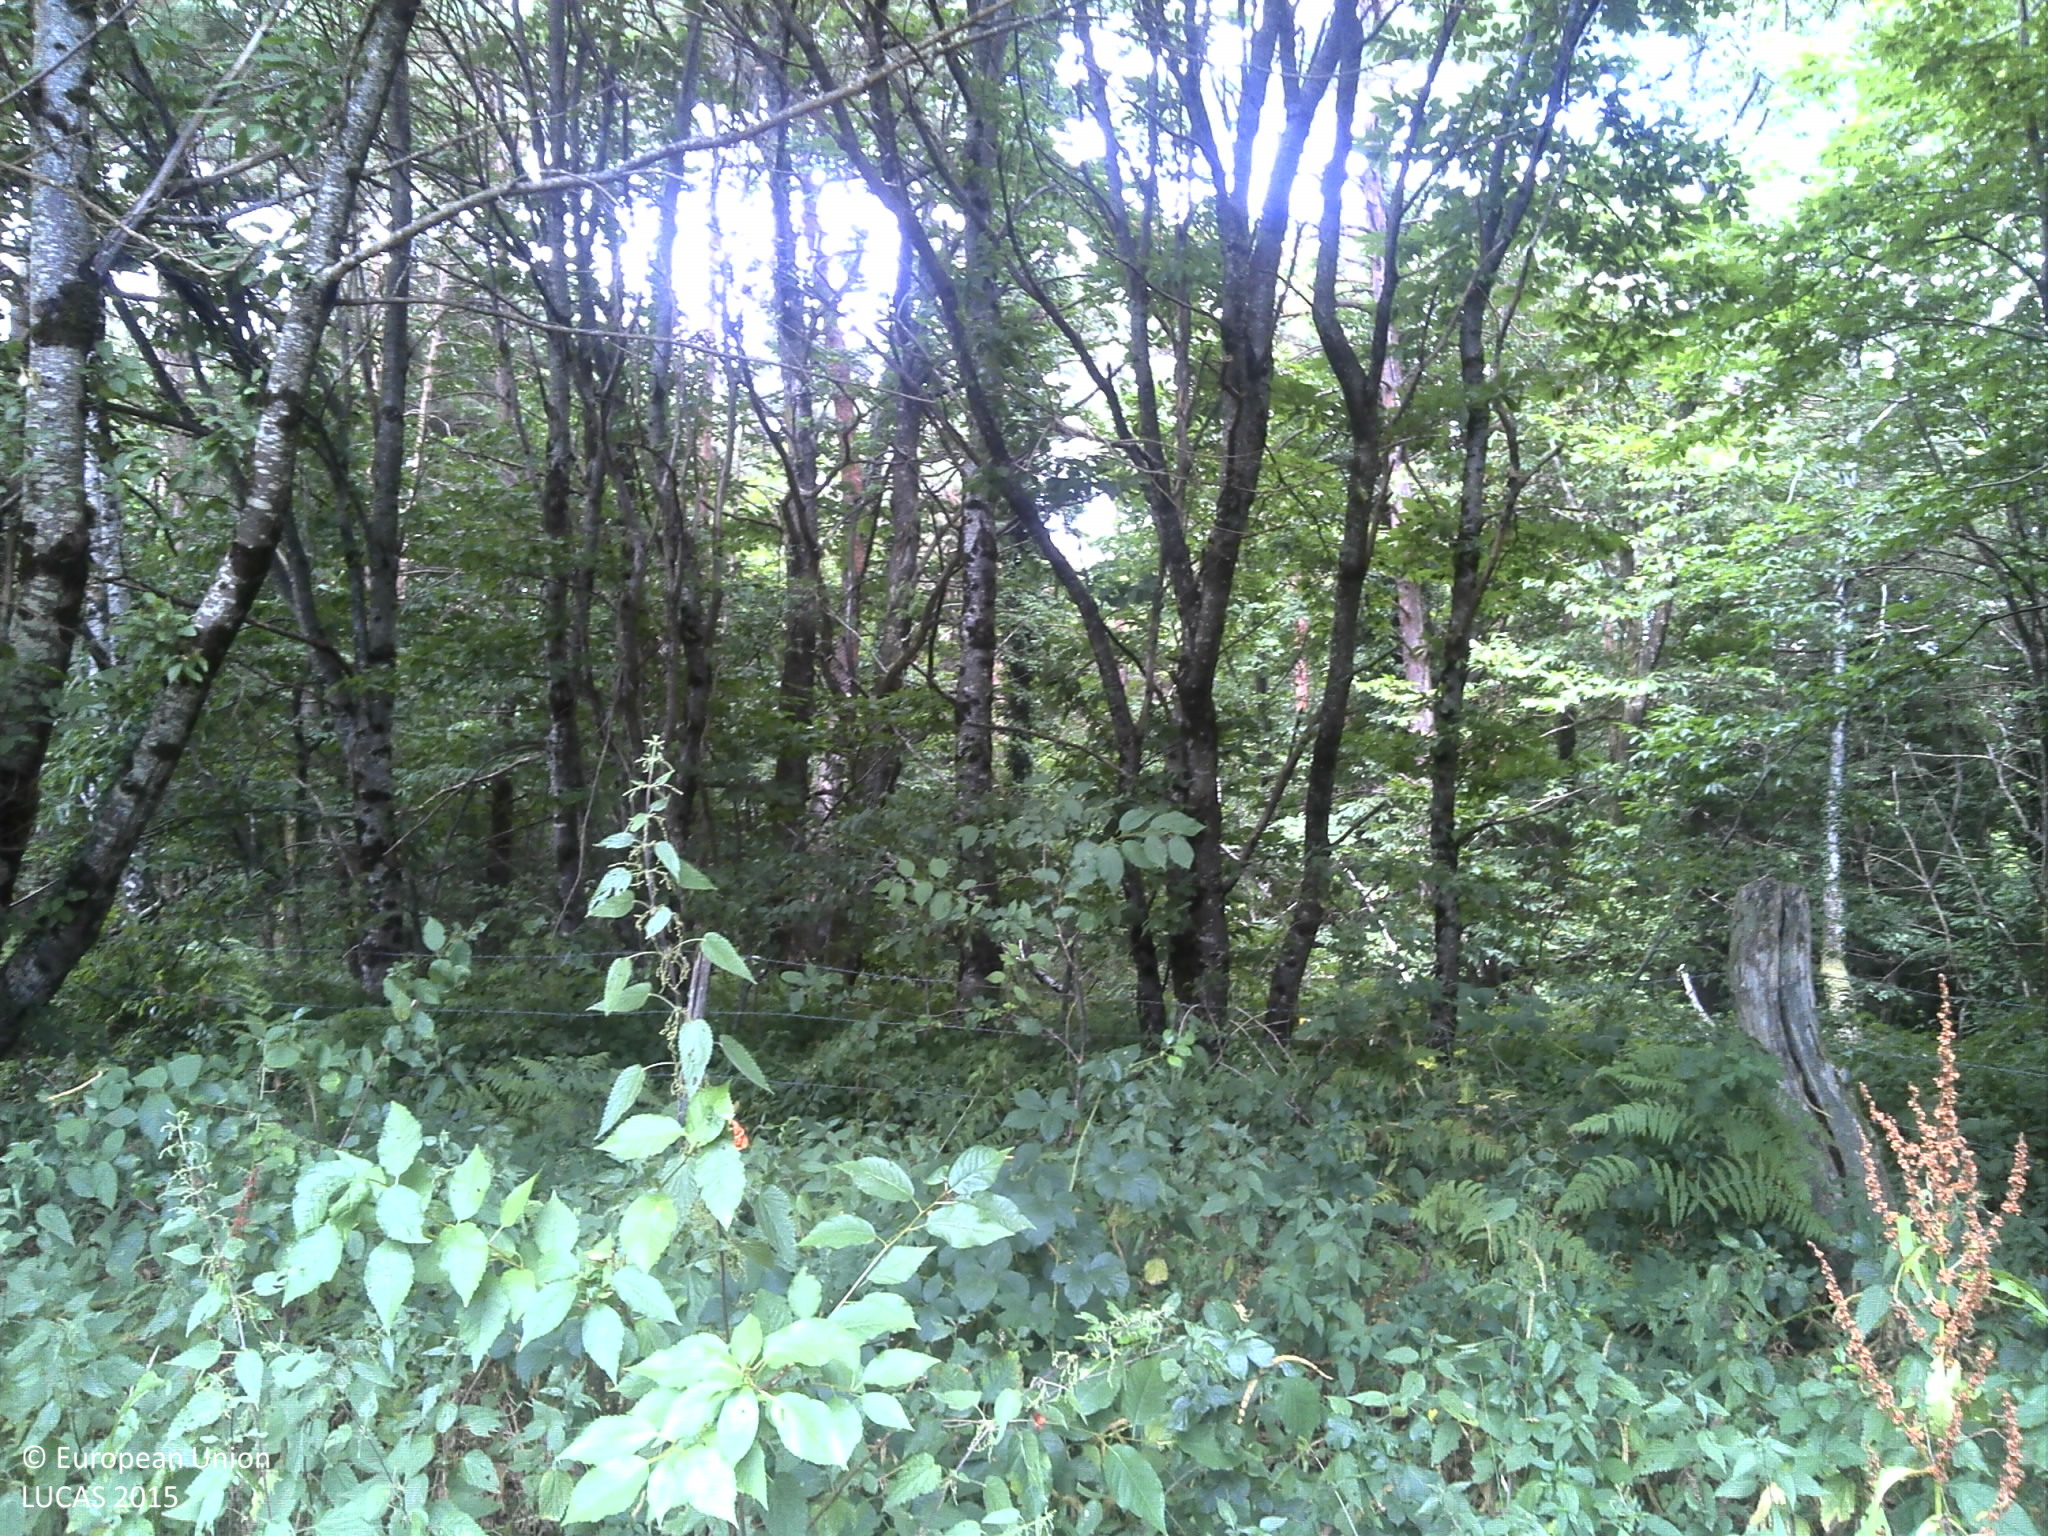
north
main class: Grassland
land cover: Grassland without tree/shrub cover
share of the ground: > 75 %
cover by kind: herbaceous plants 90 %, unconsolidated bare surface 10 %
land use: Agriculture (excluding fallow land and kitchen gardens)
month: July
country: FR
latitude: 44.9790
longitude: 1.9456
